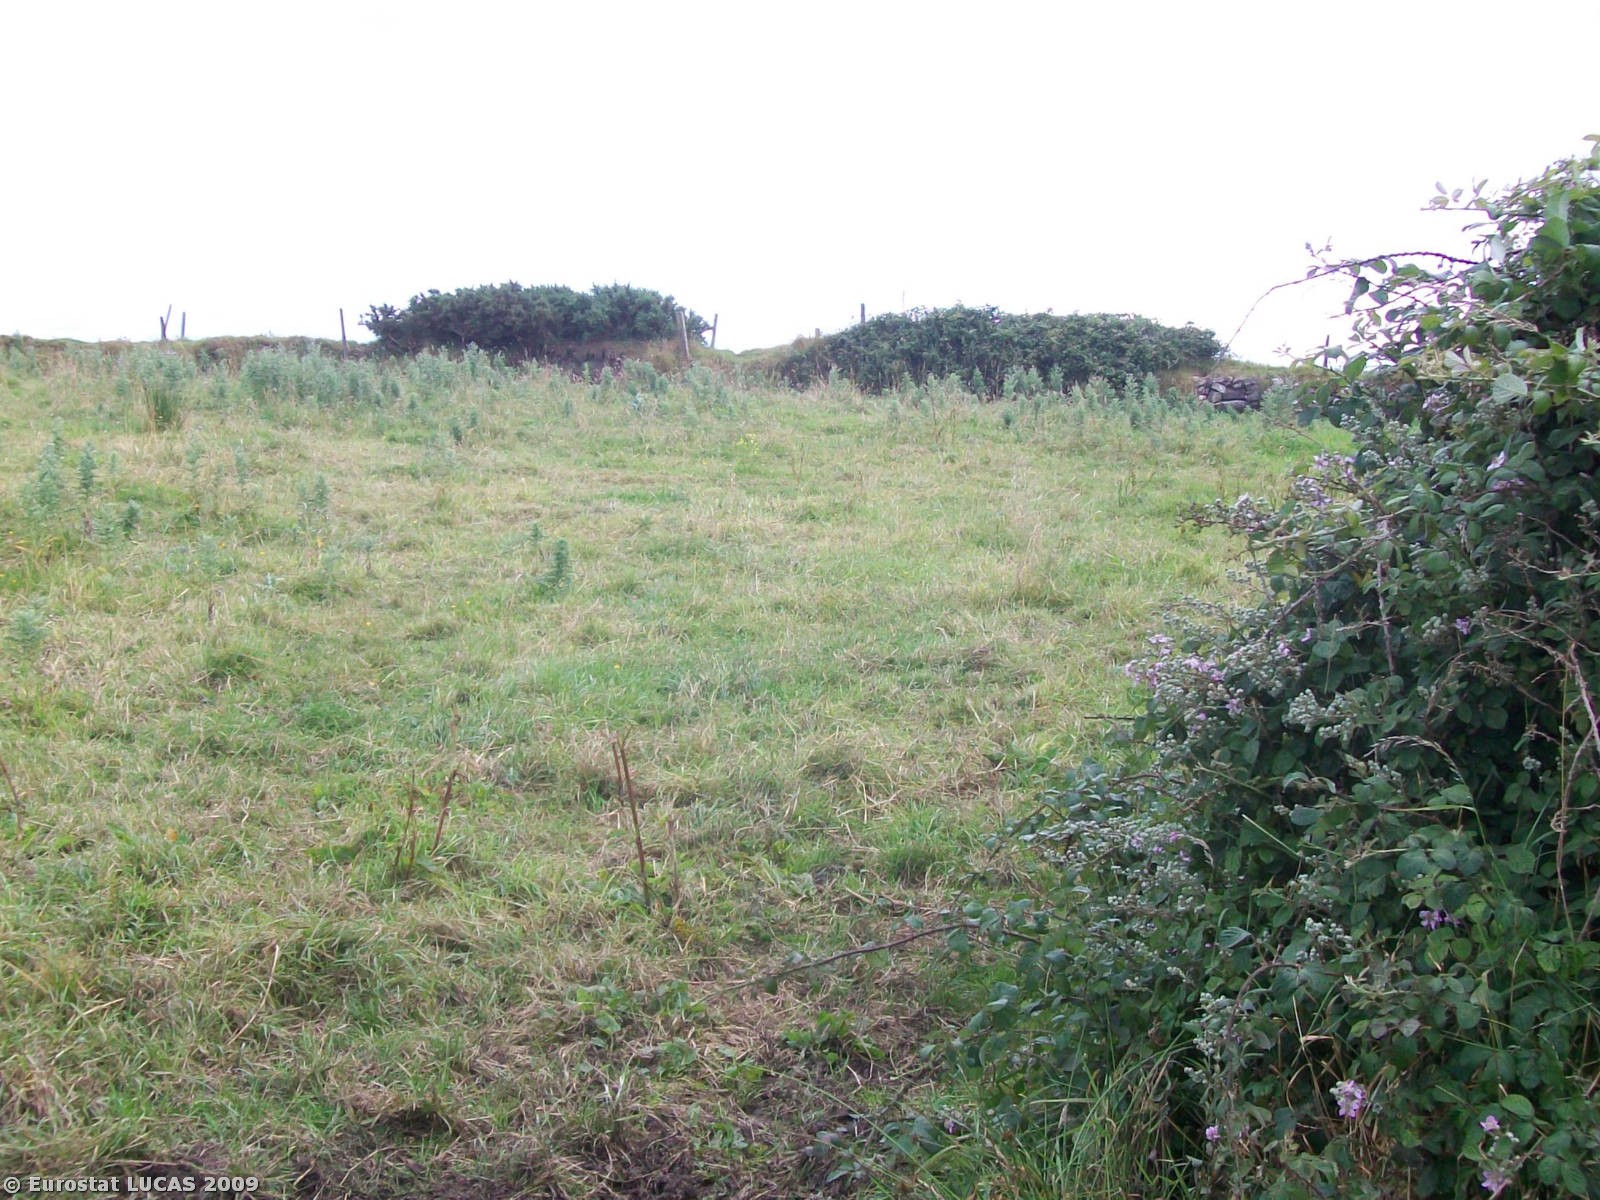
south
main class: Grassland
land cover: Grassland without tree/shrub cover
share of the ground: > 75 %
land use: Agriculture (excluding fallow land and kitchen gardens)
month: July
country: IE
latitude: 54.2495
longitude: -8.9804
